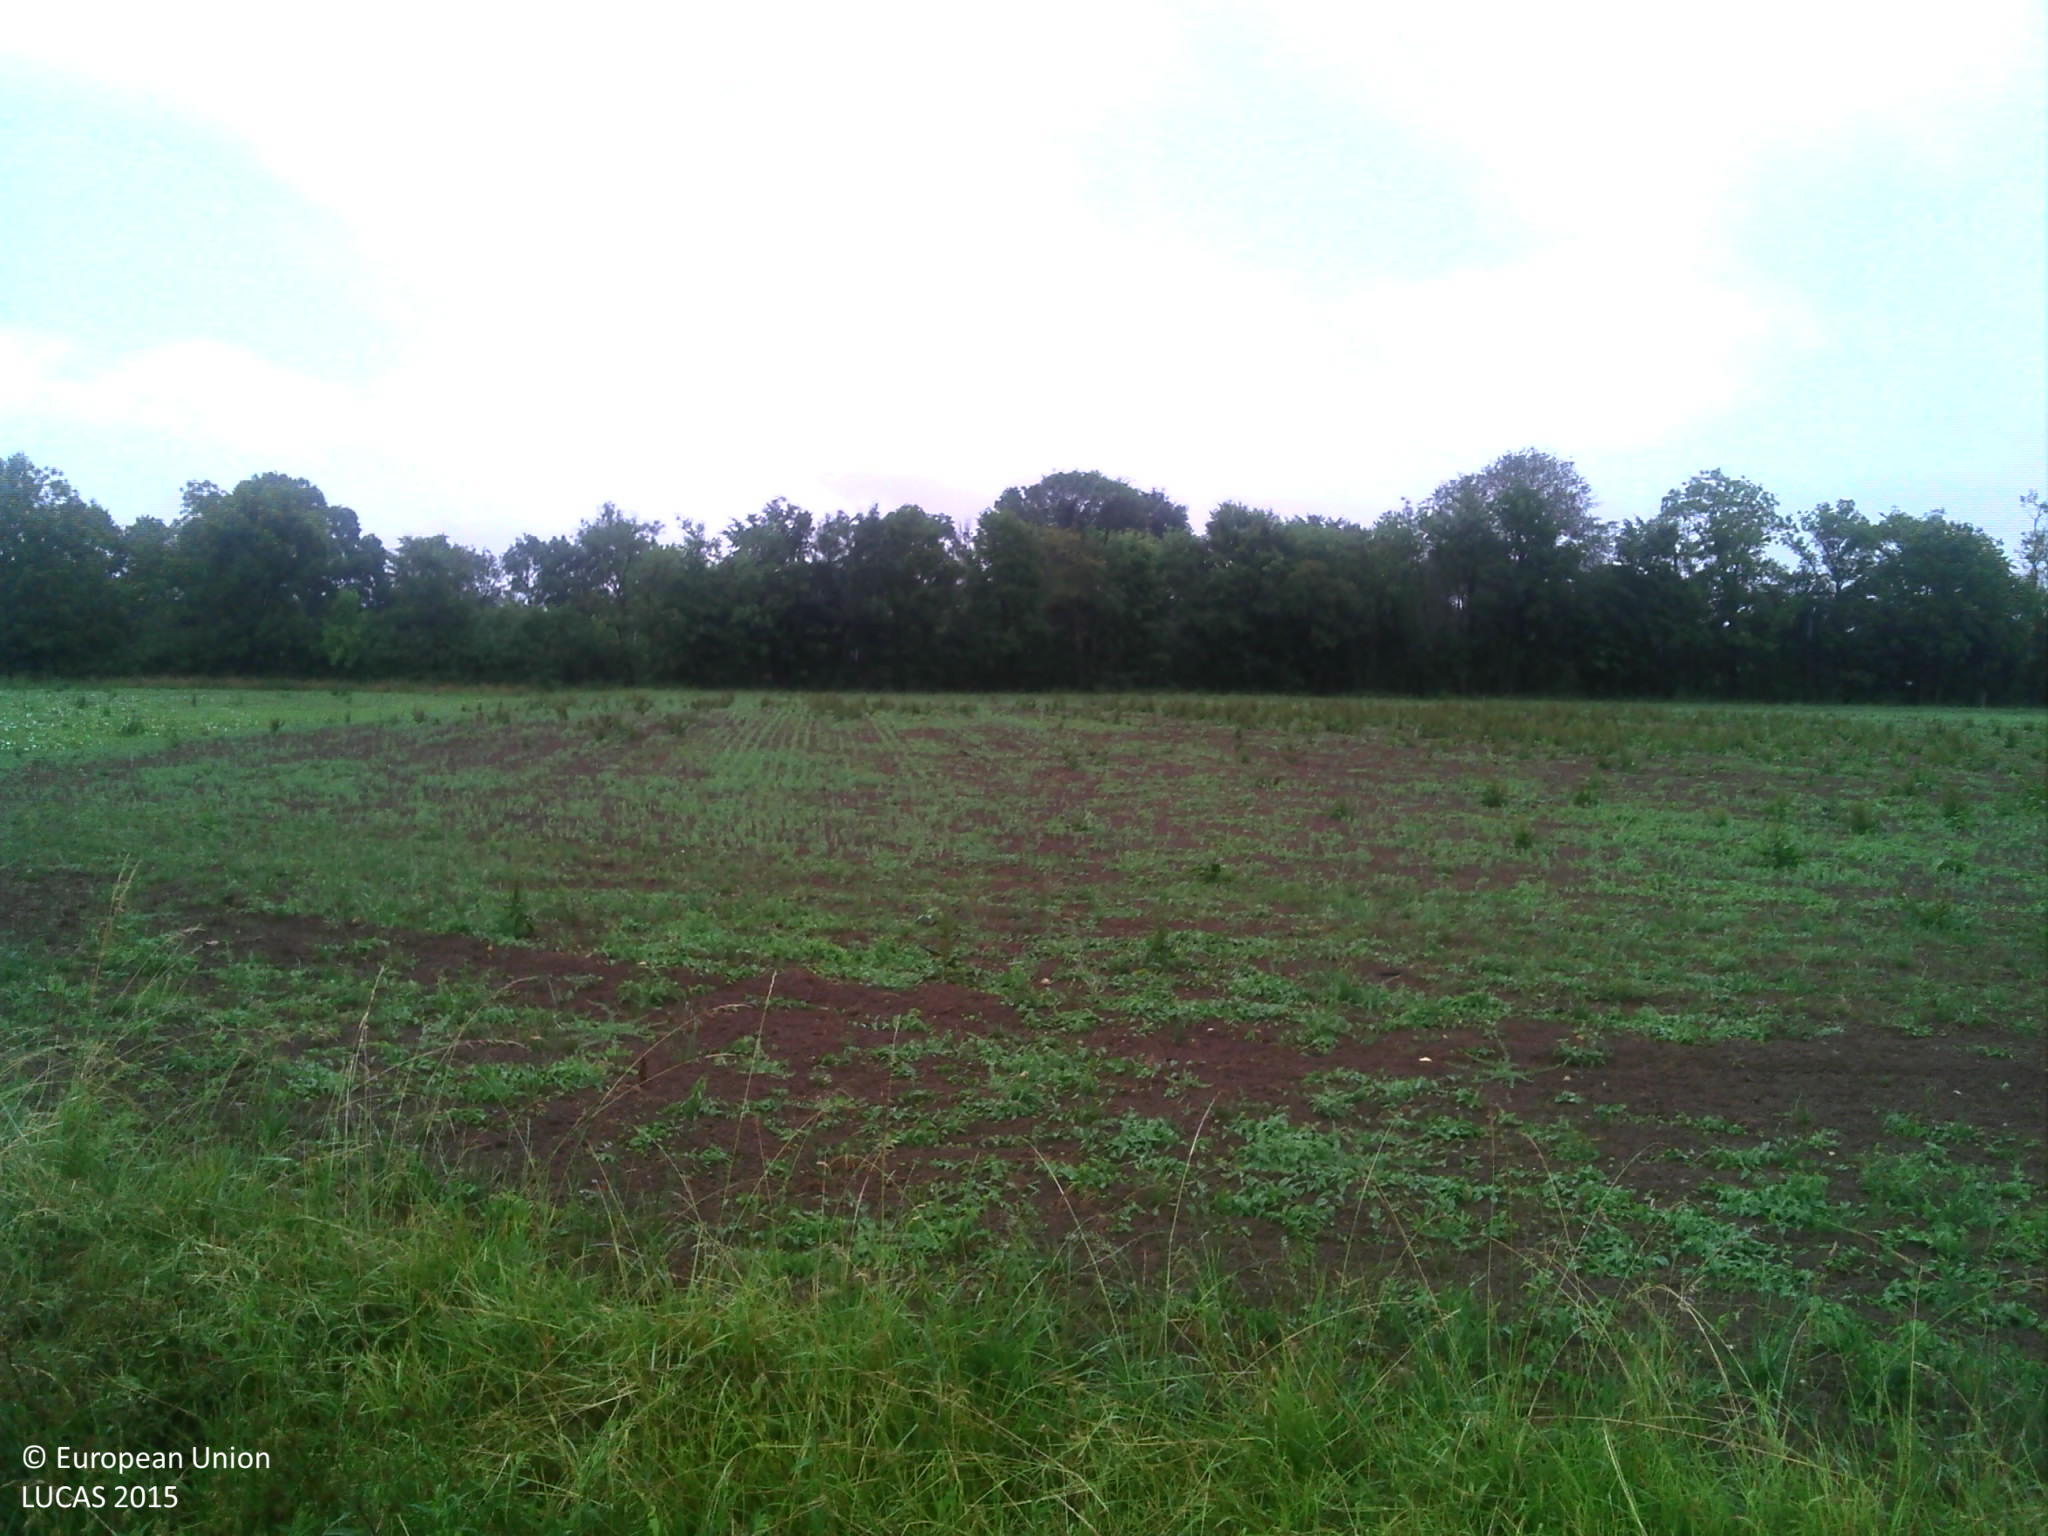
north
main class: Cropland
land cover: Dry pulses
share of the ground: > 75 %
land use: Agriculture (excluding fallow land and kitchen gardens)
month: June
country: FR
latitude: 47.3179
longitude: 5.4368
